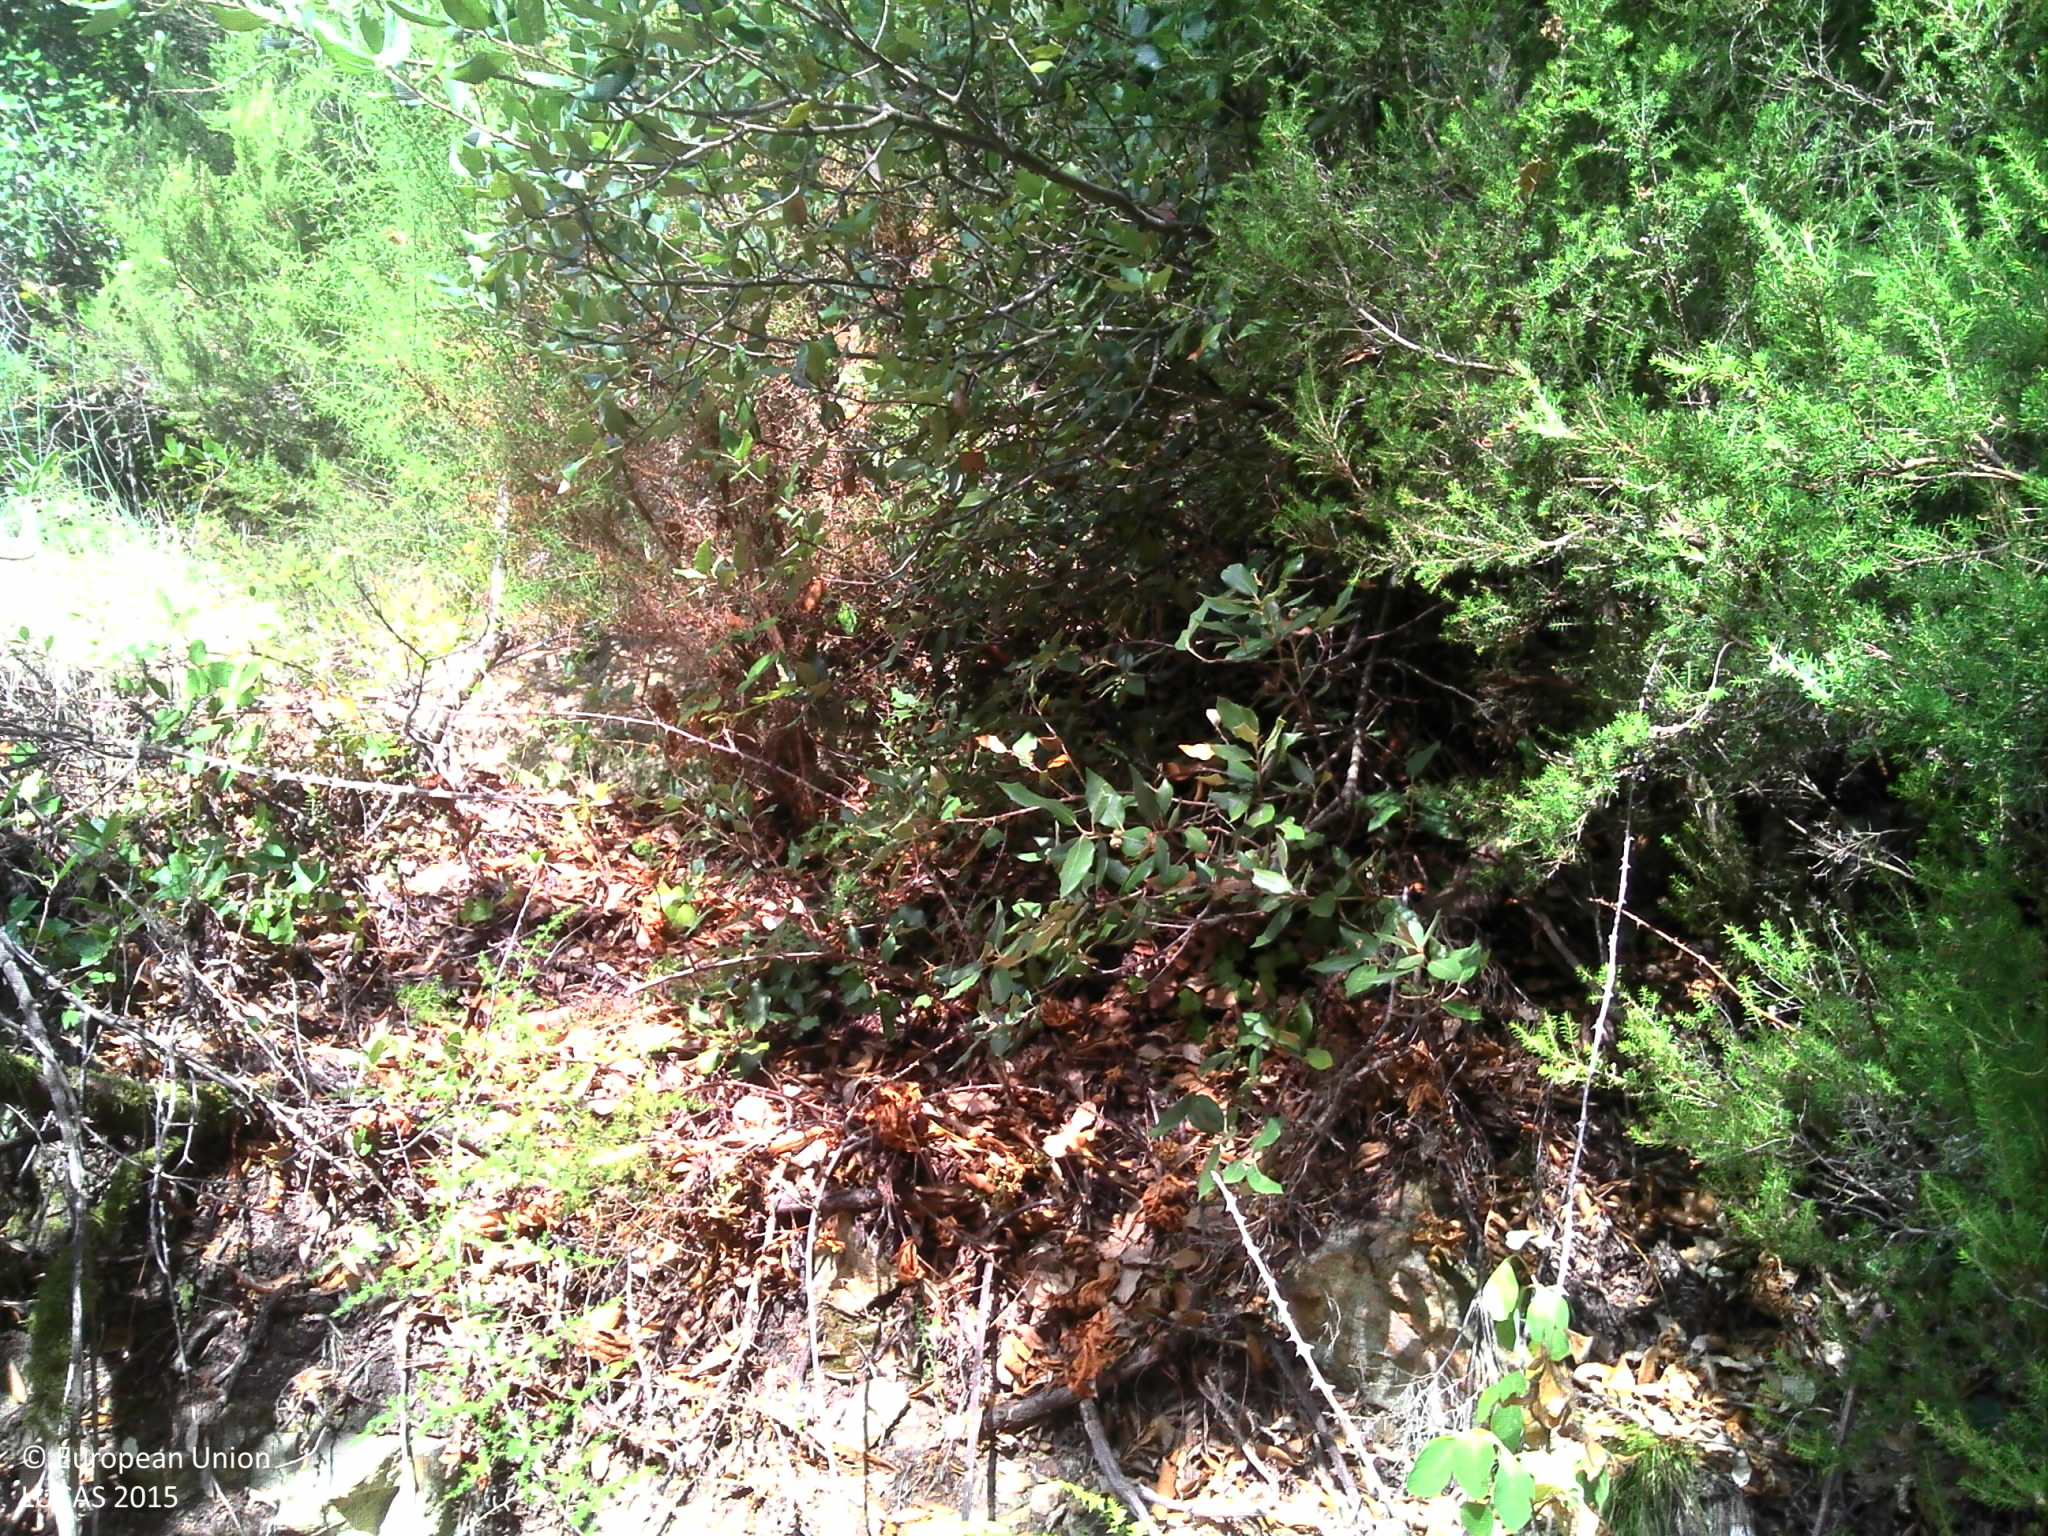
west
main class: Woodland
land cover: Broadleaved woodland
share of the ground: > 75 %
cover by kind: shrubs 60 %, broadleaved forest trees 40 %
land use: Semi-natural and natural areas not in use
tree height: < 5 m
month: July
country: FR
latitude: 42.5129
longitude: 2.8928
